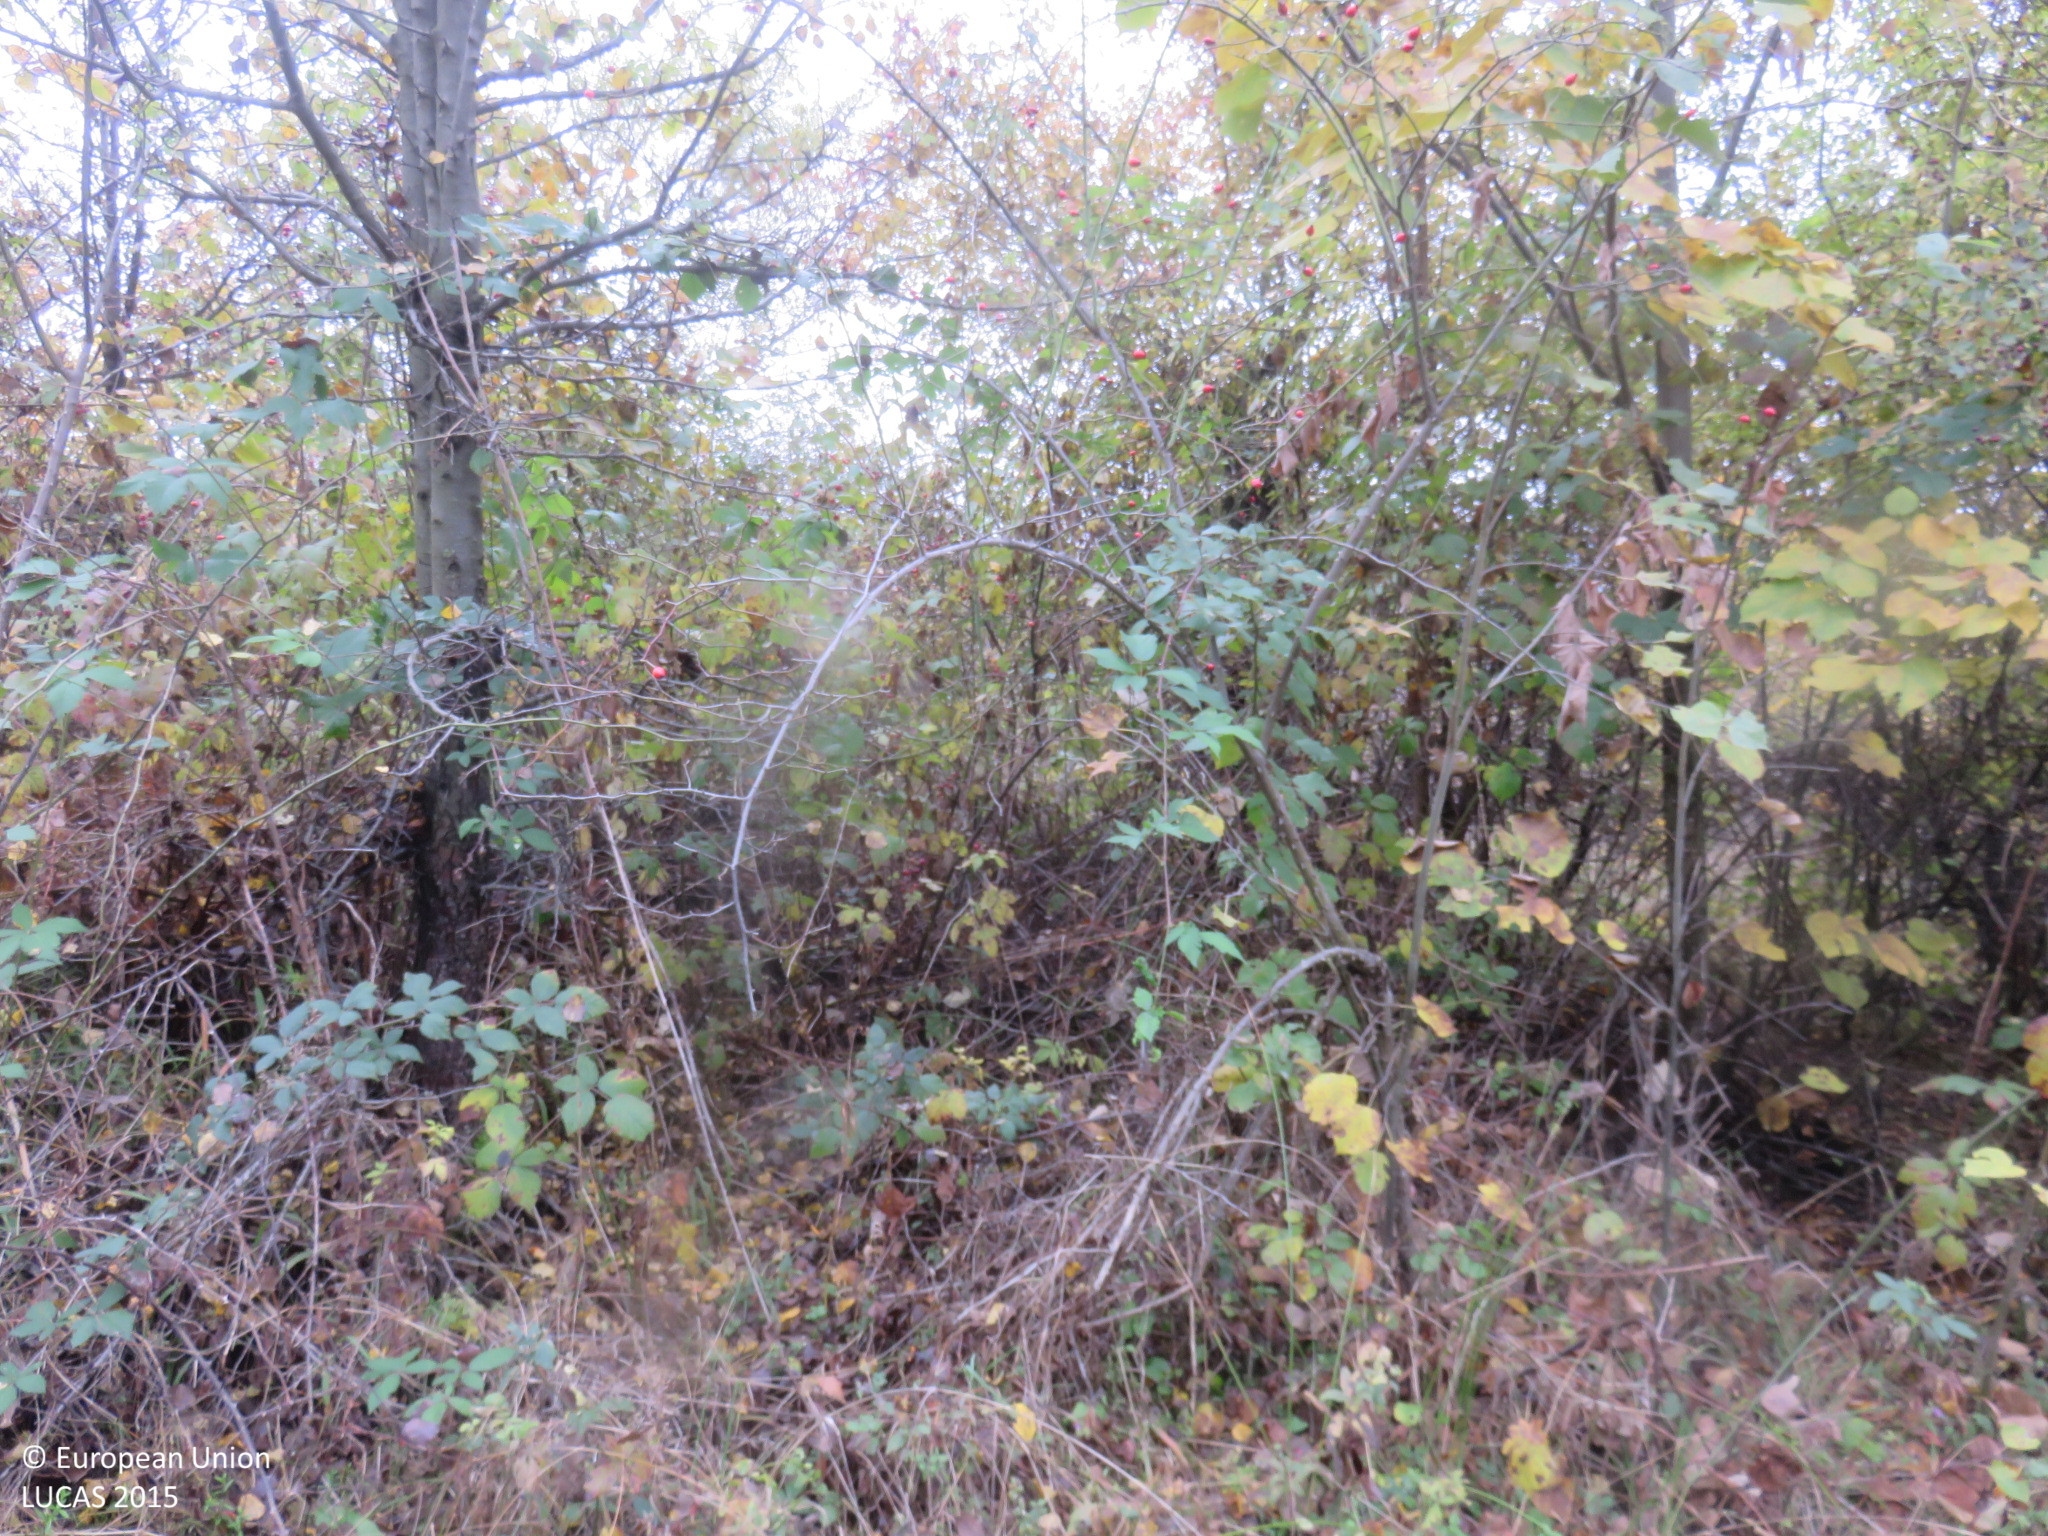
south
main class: Woodland
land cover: Pine dominated mixed woodland
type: hemiboreal forest and nemoral coniferous forest and mixed broadleaved-coniferous forest
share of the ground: > 75 %
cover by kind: coniferous forest trees 75 %, broadleaved forest trees 25 %
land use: Forestry
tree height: > 5 m
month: October
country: BG
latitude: 42.8345
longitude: 25.1015
